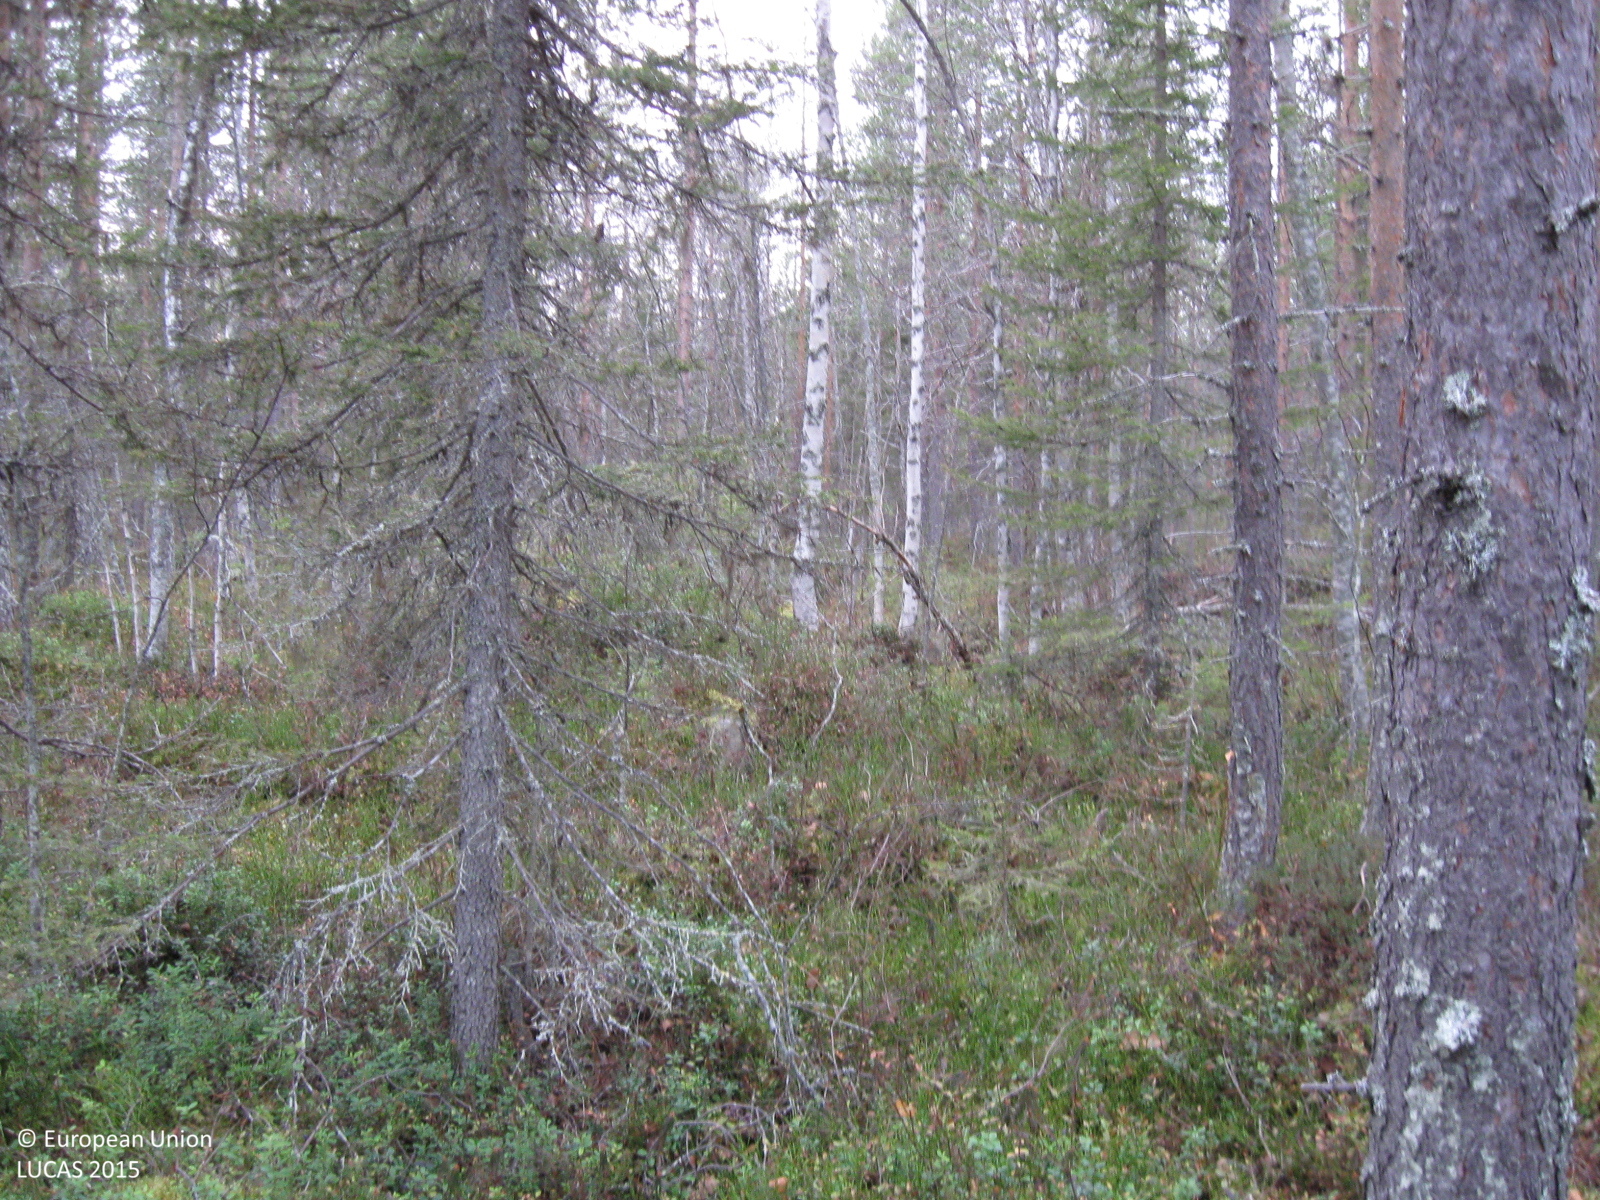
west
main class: Woodland
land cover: Pine dominated mixed woodland
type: boreal forest
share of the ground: > 75 %
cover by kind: coniferous forest trees 60 %, broadleaved forest trees 20 %, shrubs 10 %, herbaceous plants 5 %, lichens and mosses 5 %
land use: Forestry
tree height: > 5 m
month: October
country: SE
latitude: 66.1937
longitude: 22.0264
